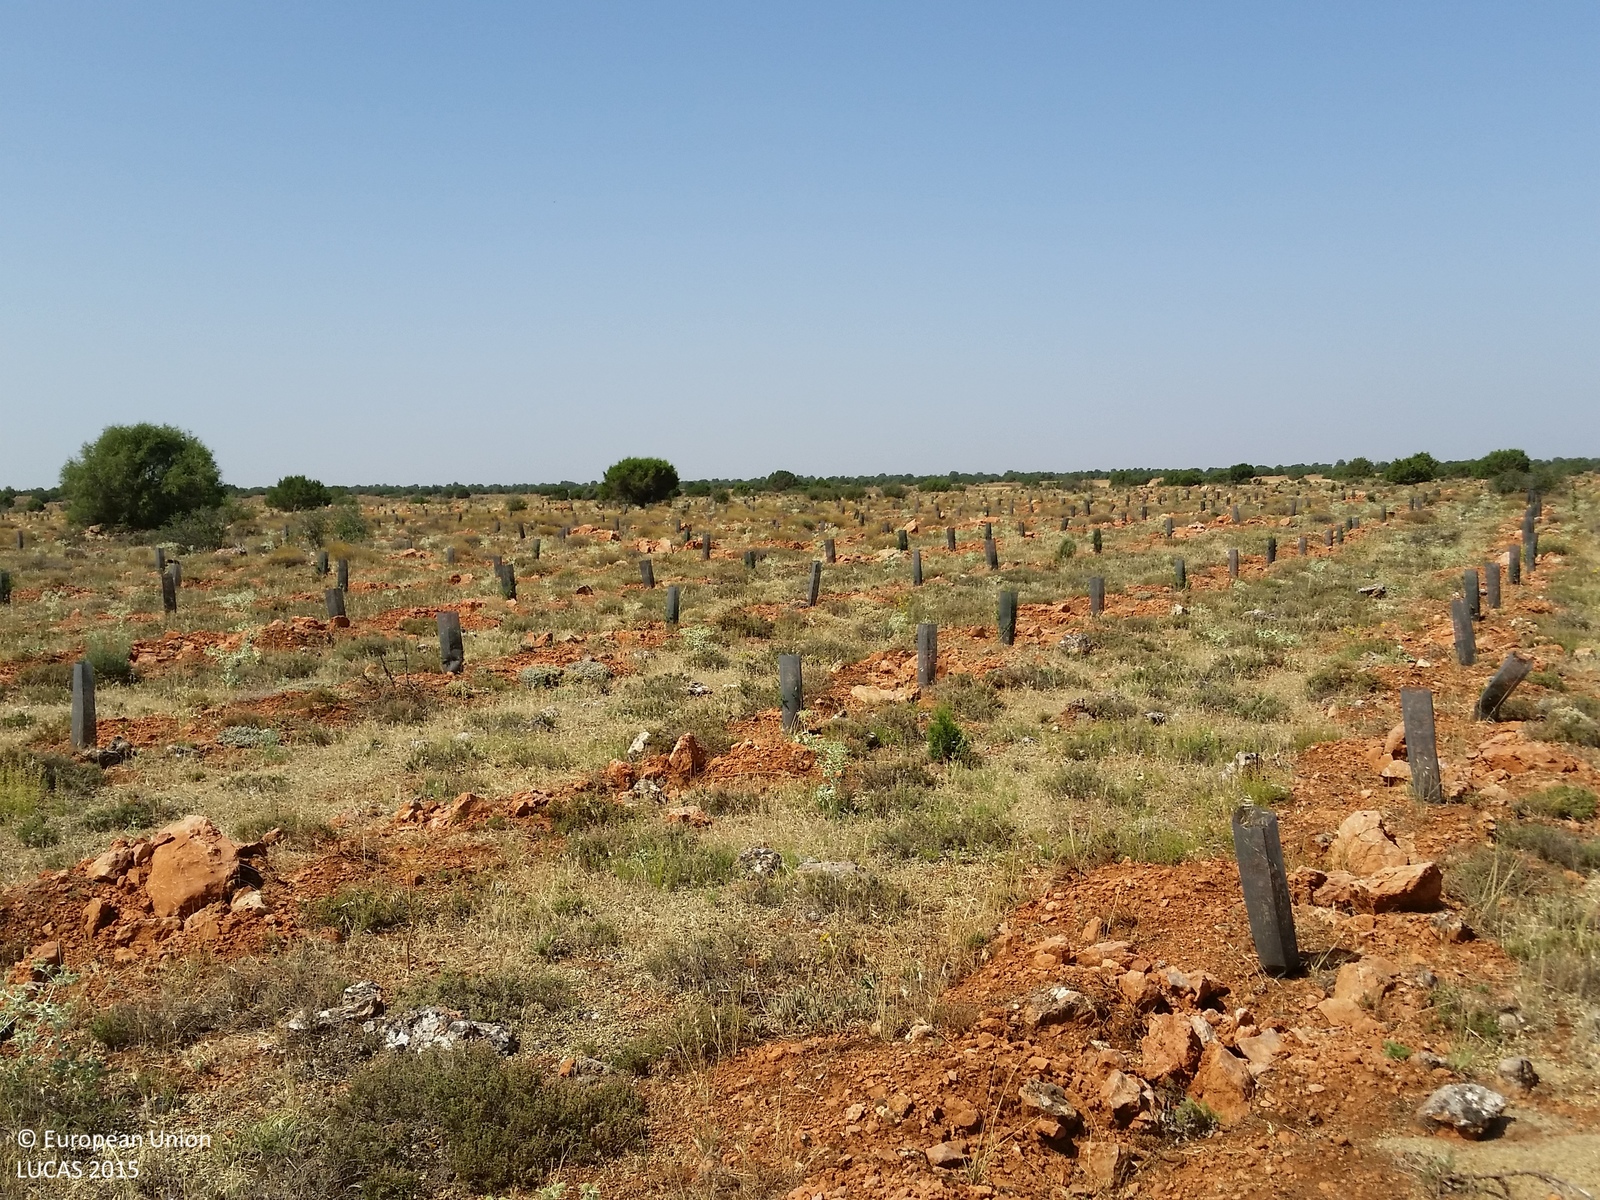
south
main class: Woodland
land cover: Broadleaved woodland
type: broadleaved evergreen forest
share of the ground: 10 - 25 %
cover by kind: unconsolidated bare surface 40 %, broadleaved forest trees 15 %, shrubs 15 %, herbaceous plants 15 %, consolidated bare surface 15 %
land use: Forestry
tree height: < 5 m
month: July
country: ES
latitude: 38.8985
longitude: -2.6311
